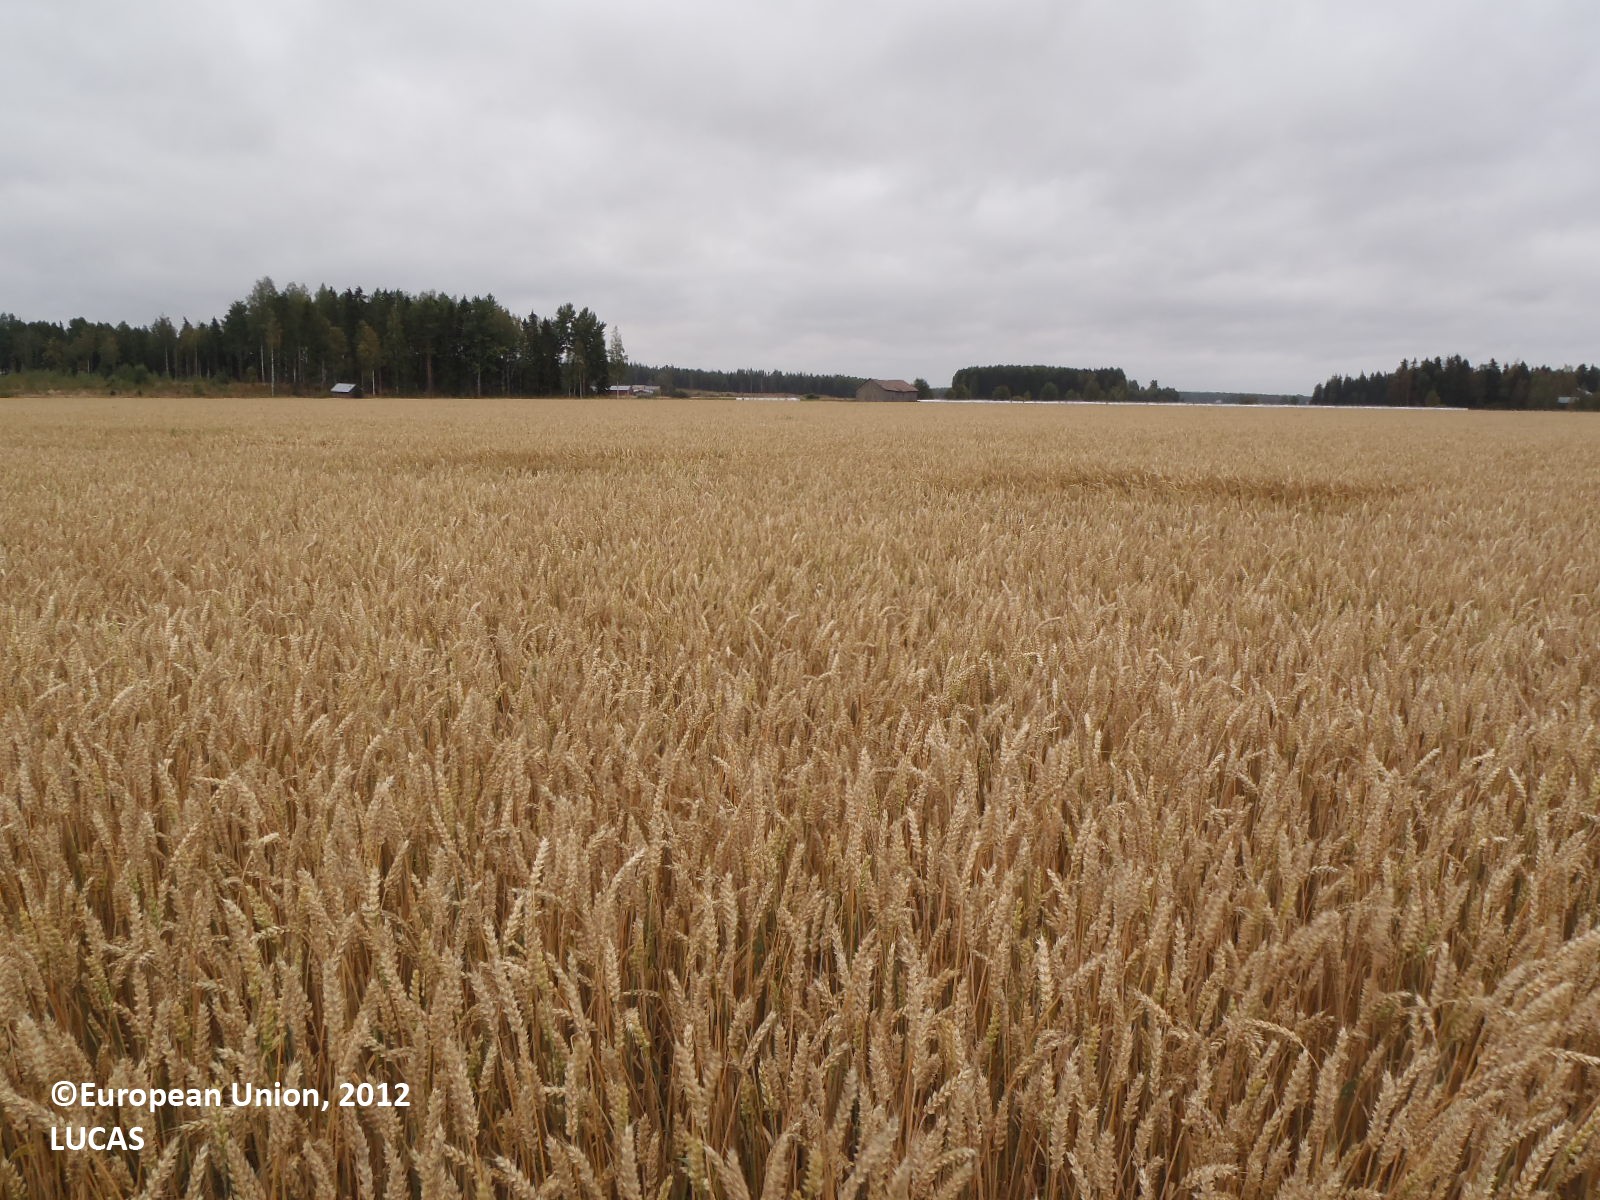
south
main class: Cropland
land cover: Common wheat
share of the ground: > 75 %
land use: Agriculture (excluding fallow land and kitchen gardens)
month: September
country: FI
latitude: 60.7792
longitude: 22.8363
